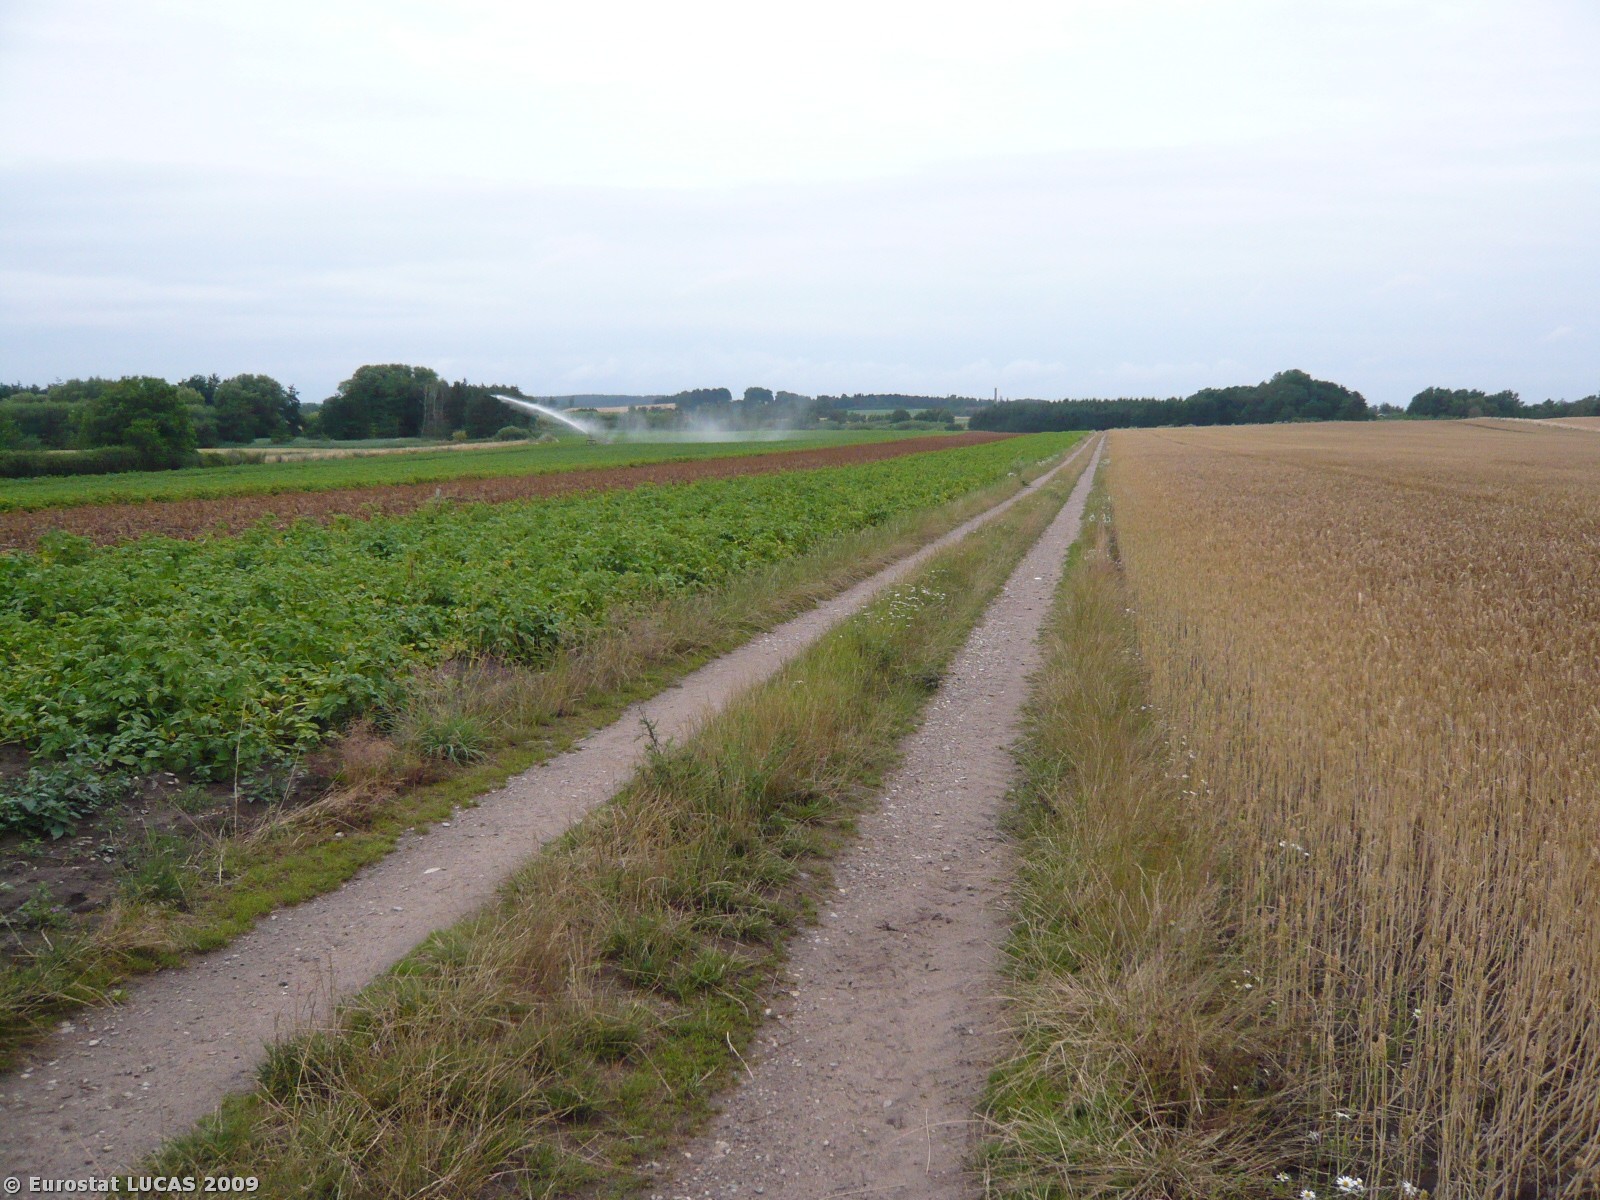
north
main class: Cropland
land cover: Common wheat
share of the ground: > 75 %
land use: Agriculture (excluding fallow land and kitchen gardens)
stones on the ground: 25 - 50 %
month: July
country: DK
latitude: 55.8122
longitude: 12.0247
